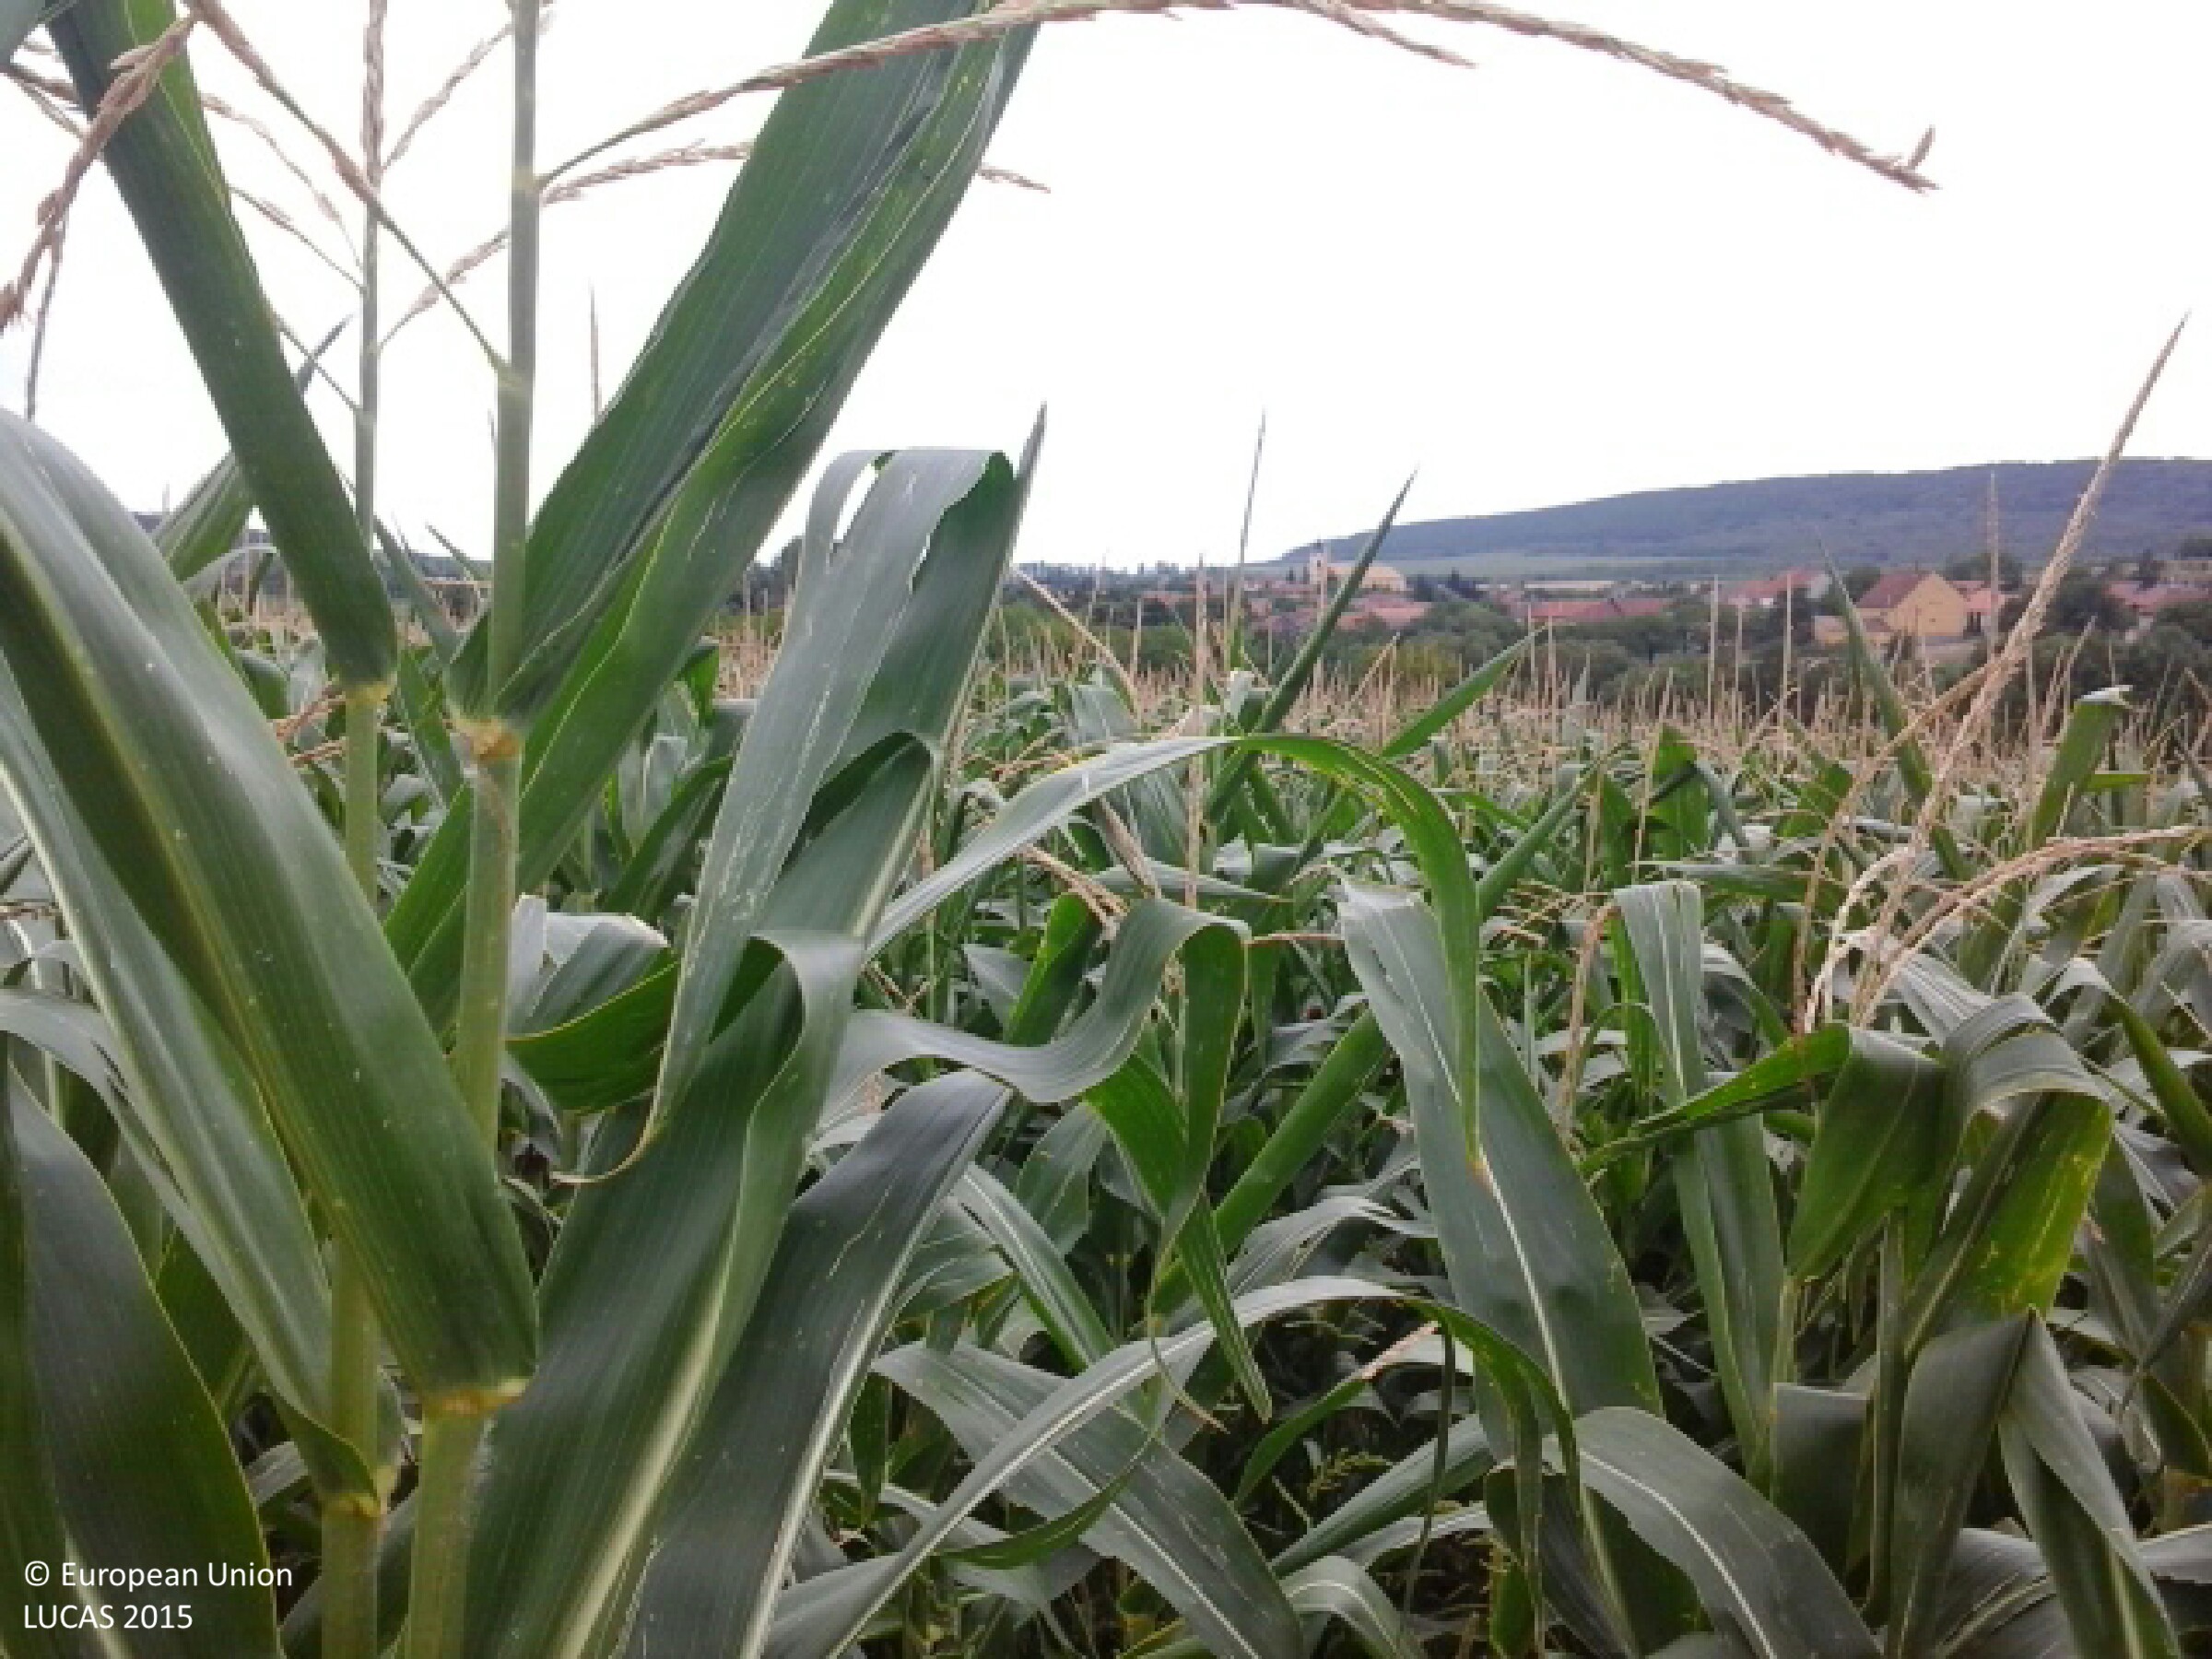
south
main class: Cropland
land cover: Maize
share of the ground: > 75 %
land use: Agriculture (excluding fallow land and kitchen gardens)
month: July
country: HU
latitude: 48.3434
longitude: 21.5288
